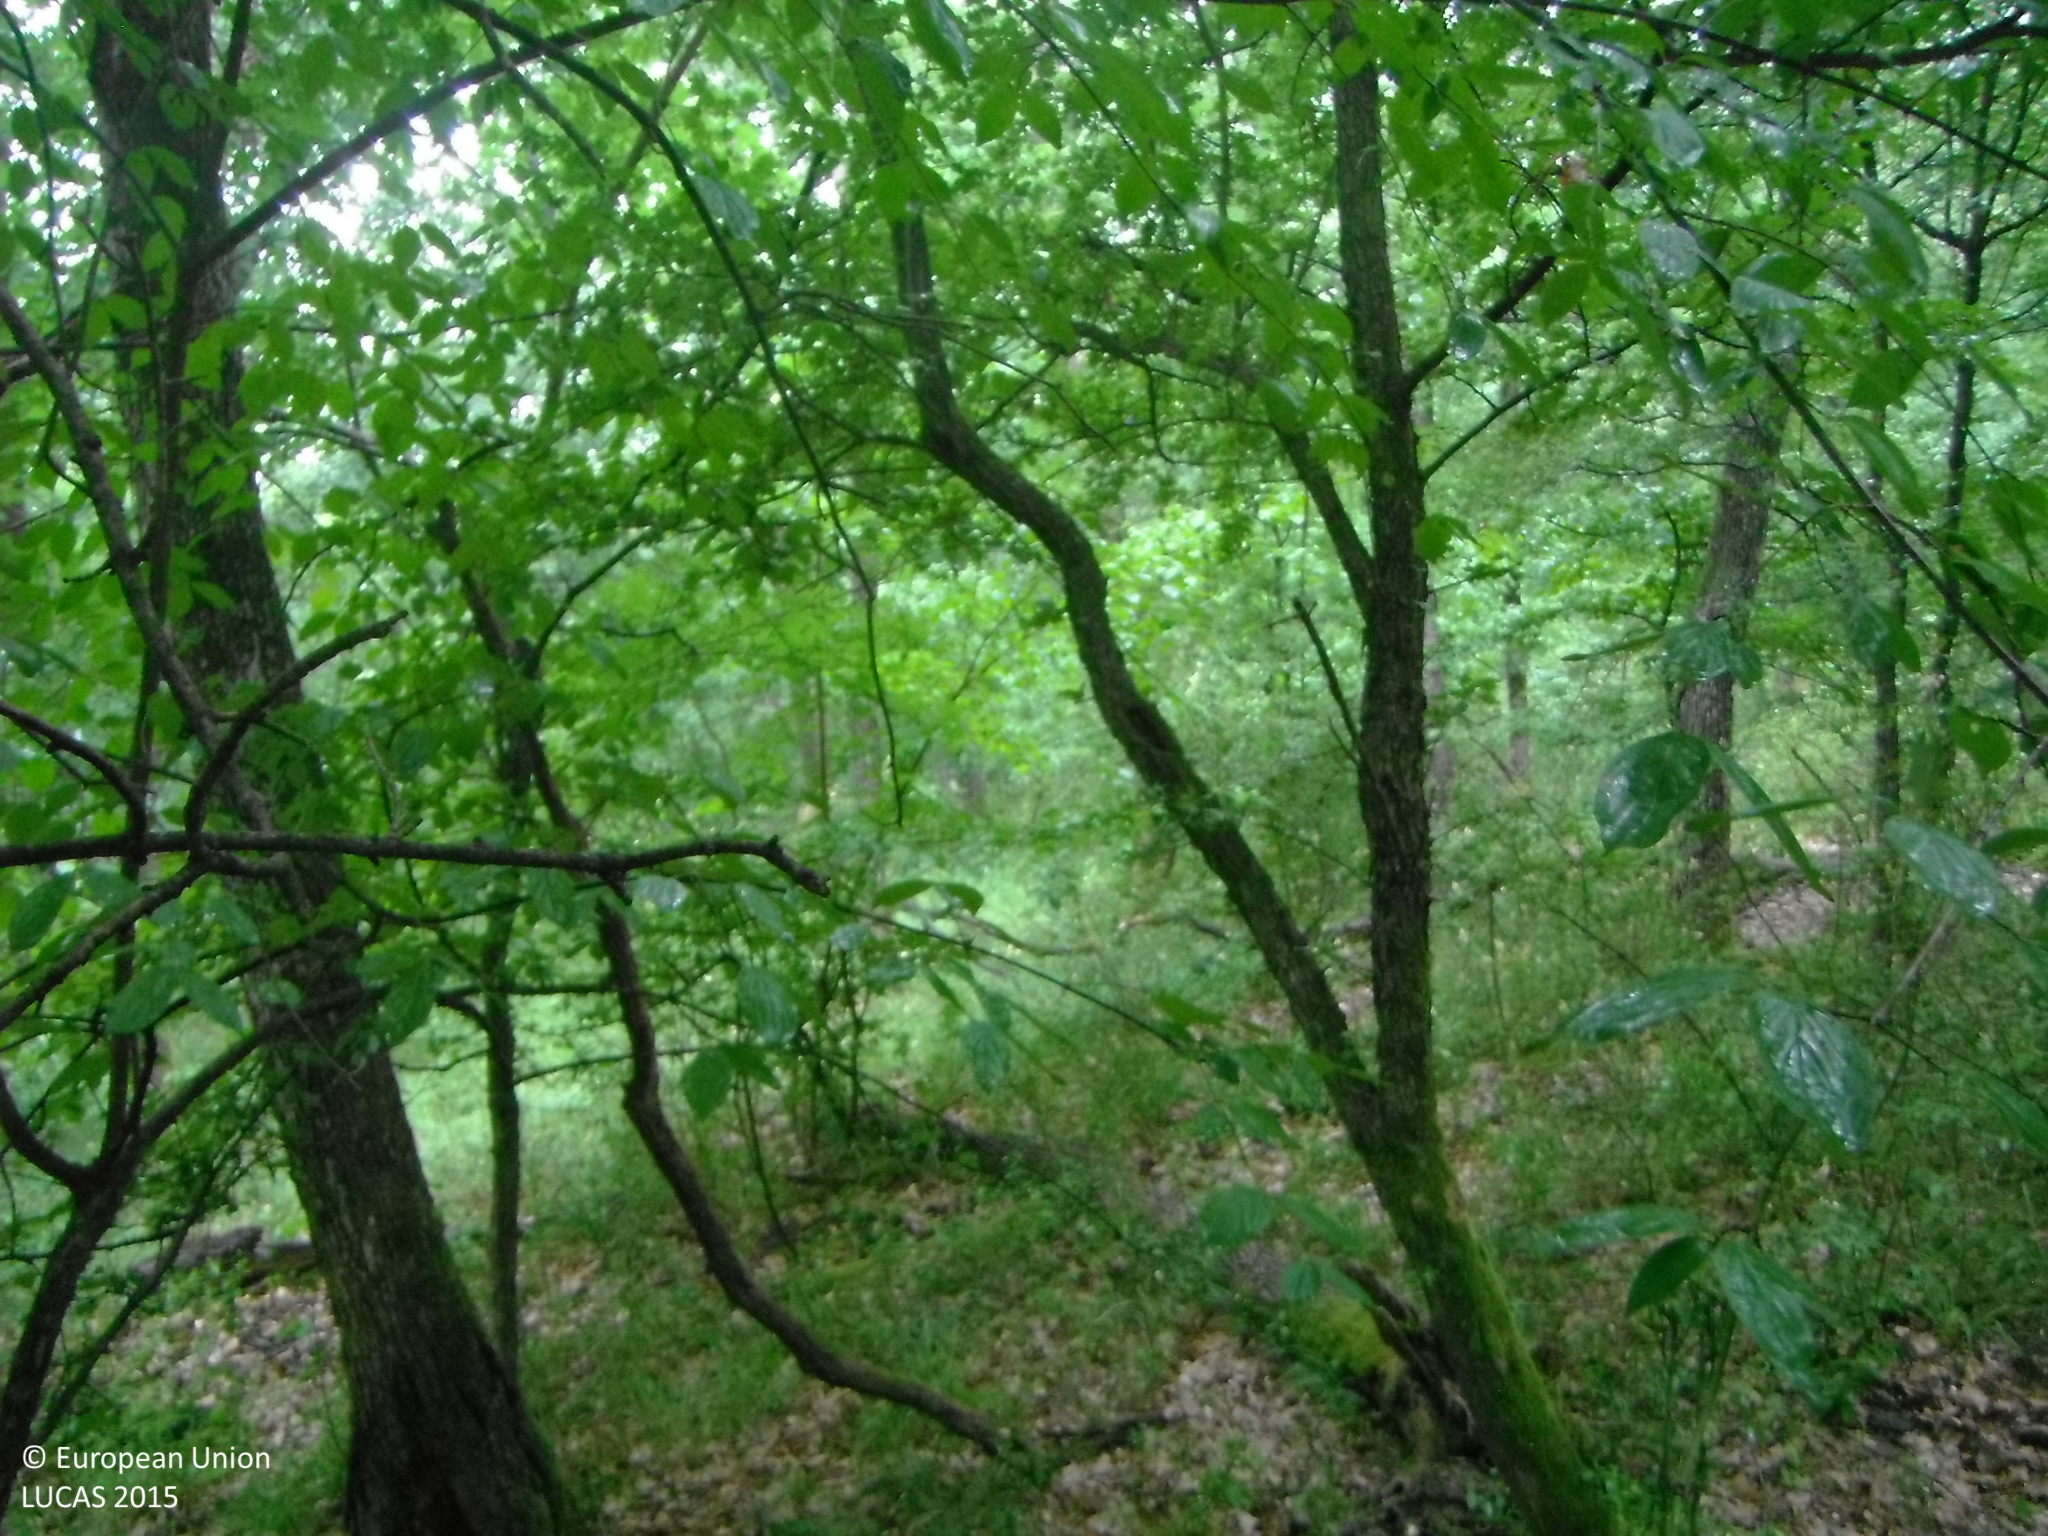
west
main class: Woodland
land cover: Broadleaved woodland
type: mesophytic deciduous forest
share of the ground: > 75 %
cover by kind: broadleaved forest trees 85 %, herbaceous plants 10 %, shrubs 5 %
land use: Forestry
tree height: > 5 m
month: June
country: SK
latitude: 48.7204
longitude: 18.3486
